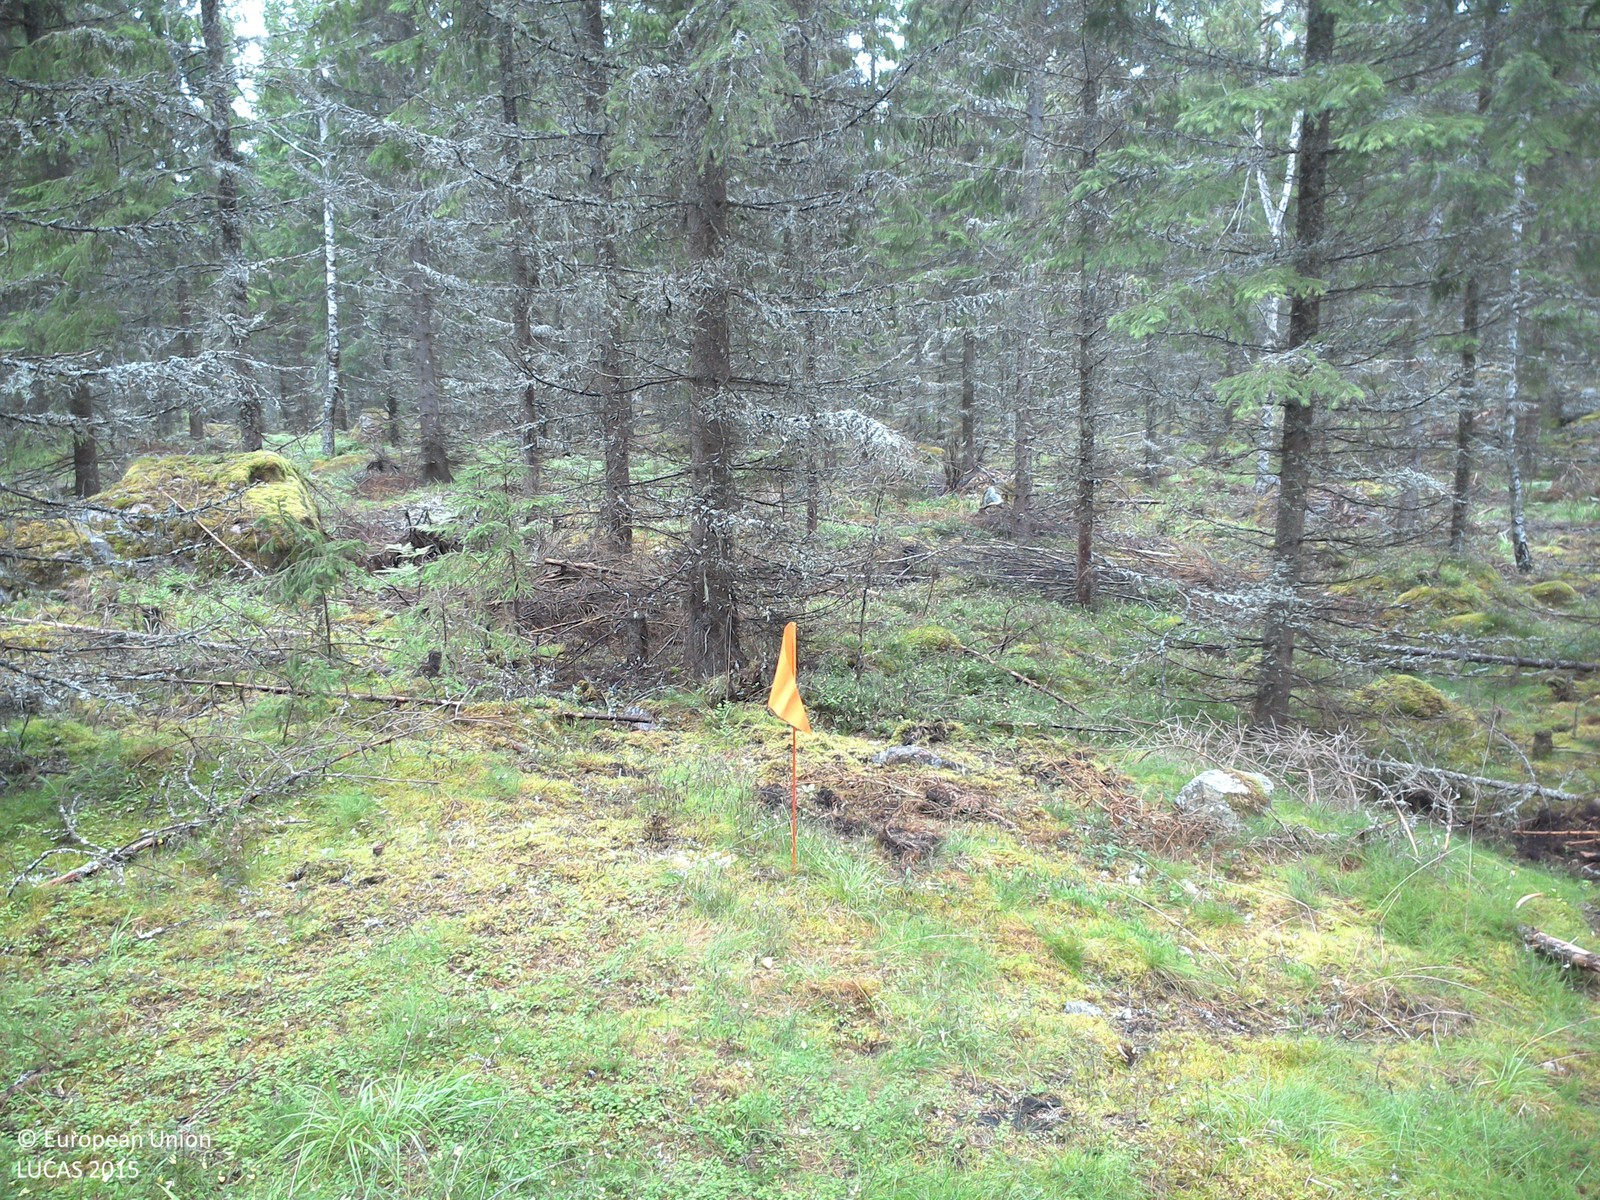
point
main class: Woodland
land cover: Spruce dominated coniferous woodland
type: boreal forest
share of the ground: 50 - 75 %
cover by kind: coniferous forest trees 55 %, lichens and mosses 30 %, herbaceous plants 15 %
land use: Forestry
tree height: > 5 m
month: August
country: SE
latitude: 58.2003
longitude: 15.4225
